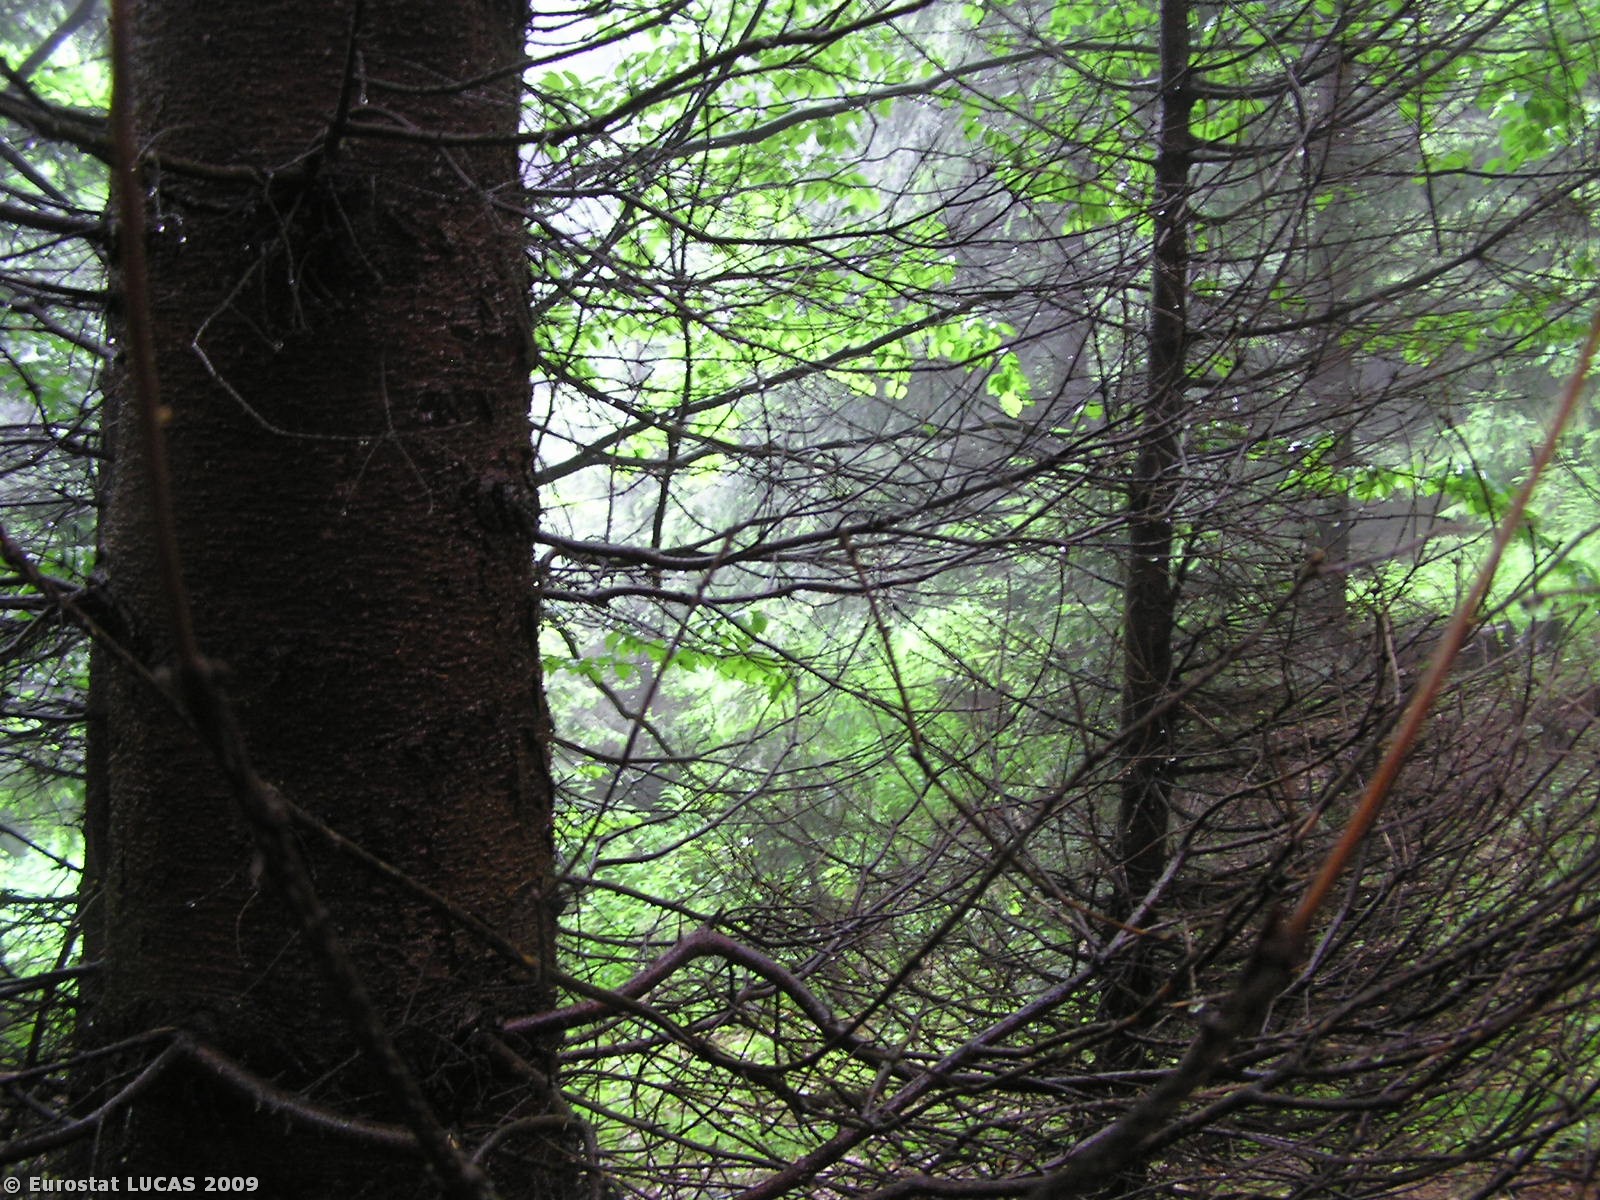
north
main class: Woodland
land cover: Mixed woodland
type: hemiboreal forest and nemoral coniferous forest and mixed broadleaved-coniferous forest
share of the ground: > 75 %
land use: Forestry
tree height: > 5 m
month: June
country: CZ
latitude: 50.1164
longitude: 17.2413
